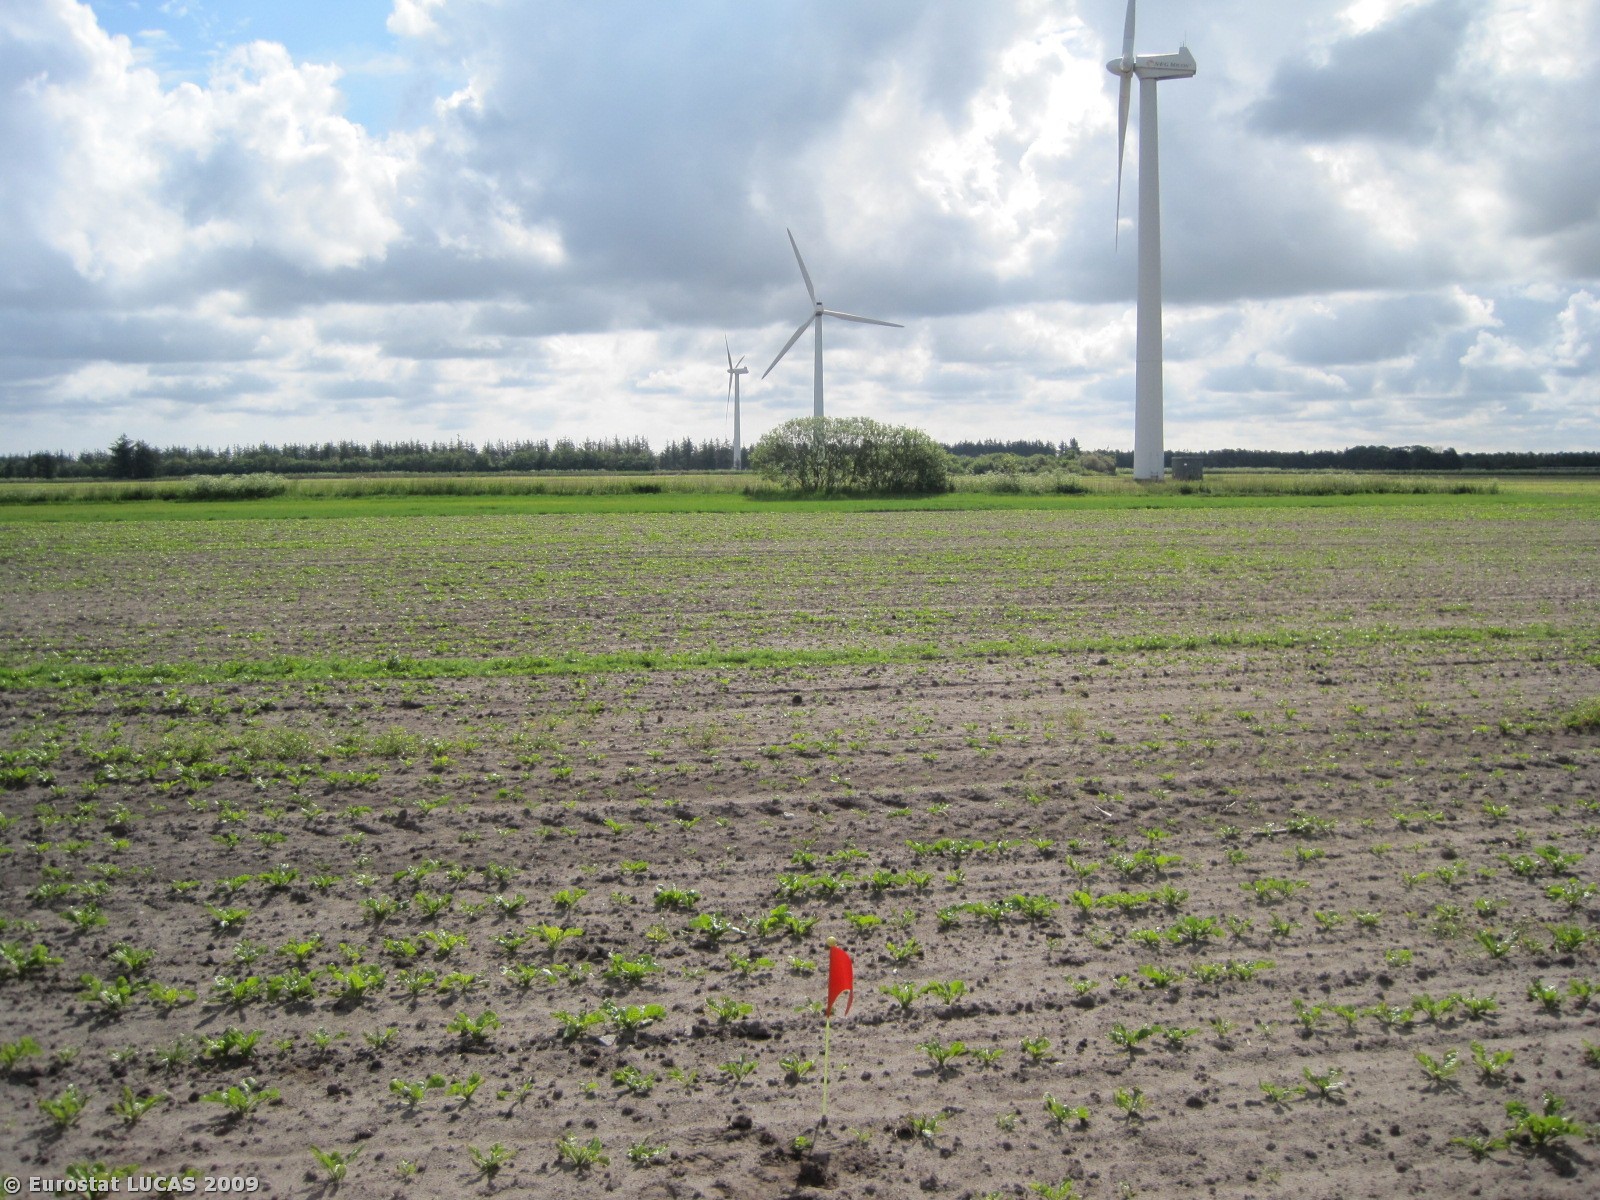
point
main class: Cropland
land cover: Sugar beet
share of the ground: 10 - 25 %
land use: Agriculture (excluding fallow land and kitchen gardens)
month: June
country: DK
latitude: 57.5720
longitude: 10.1502
